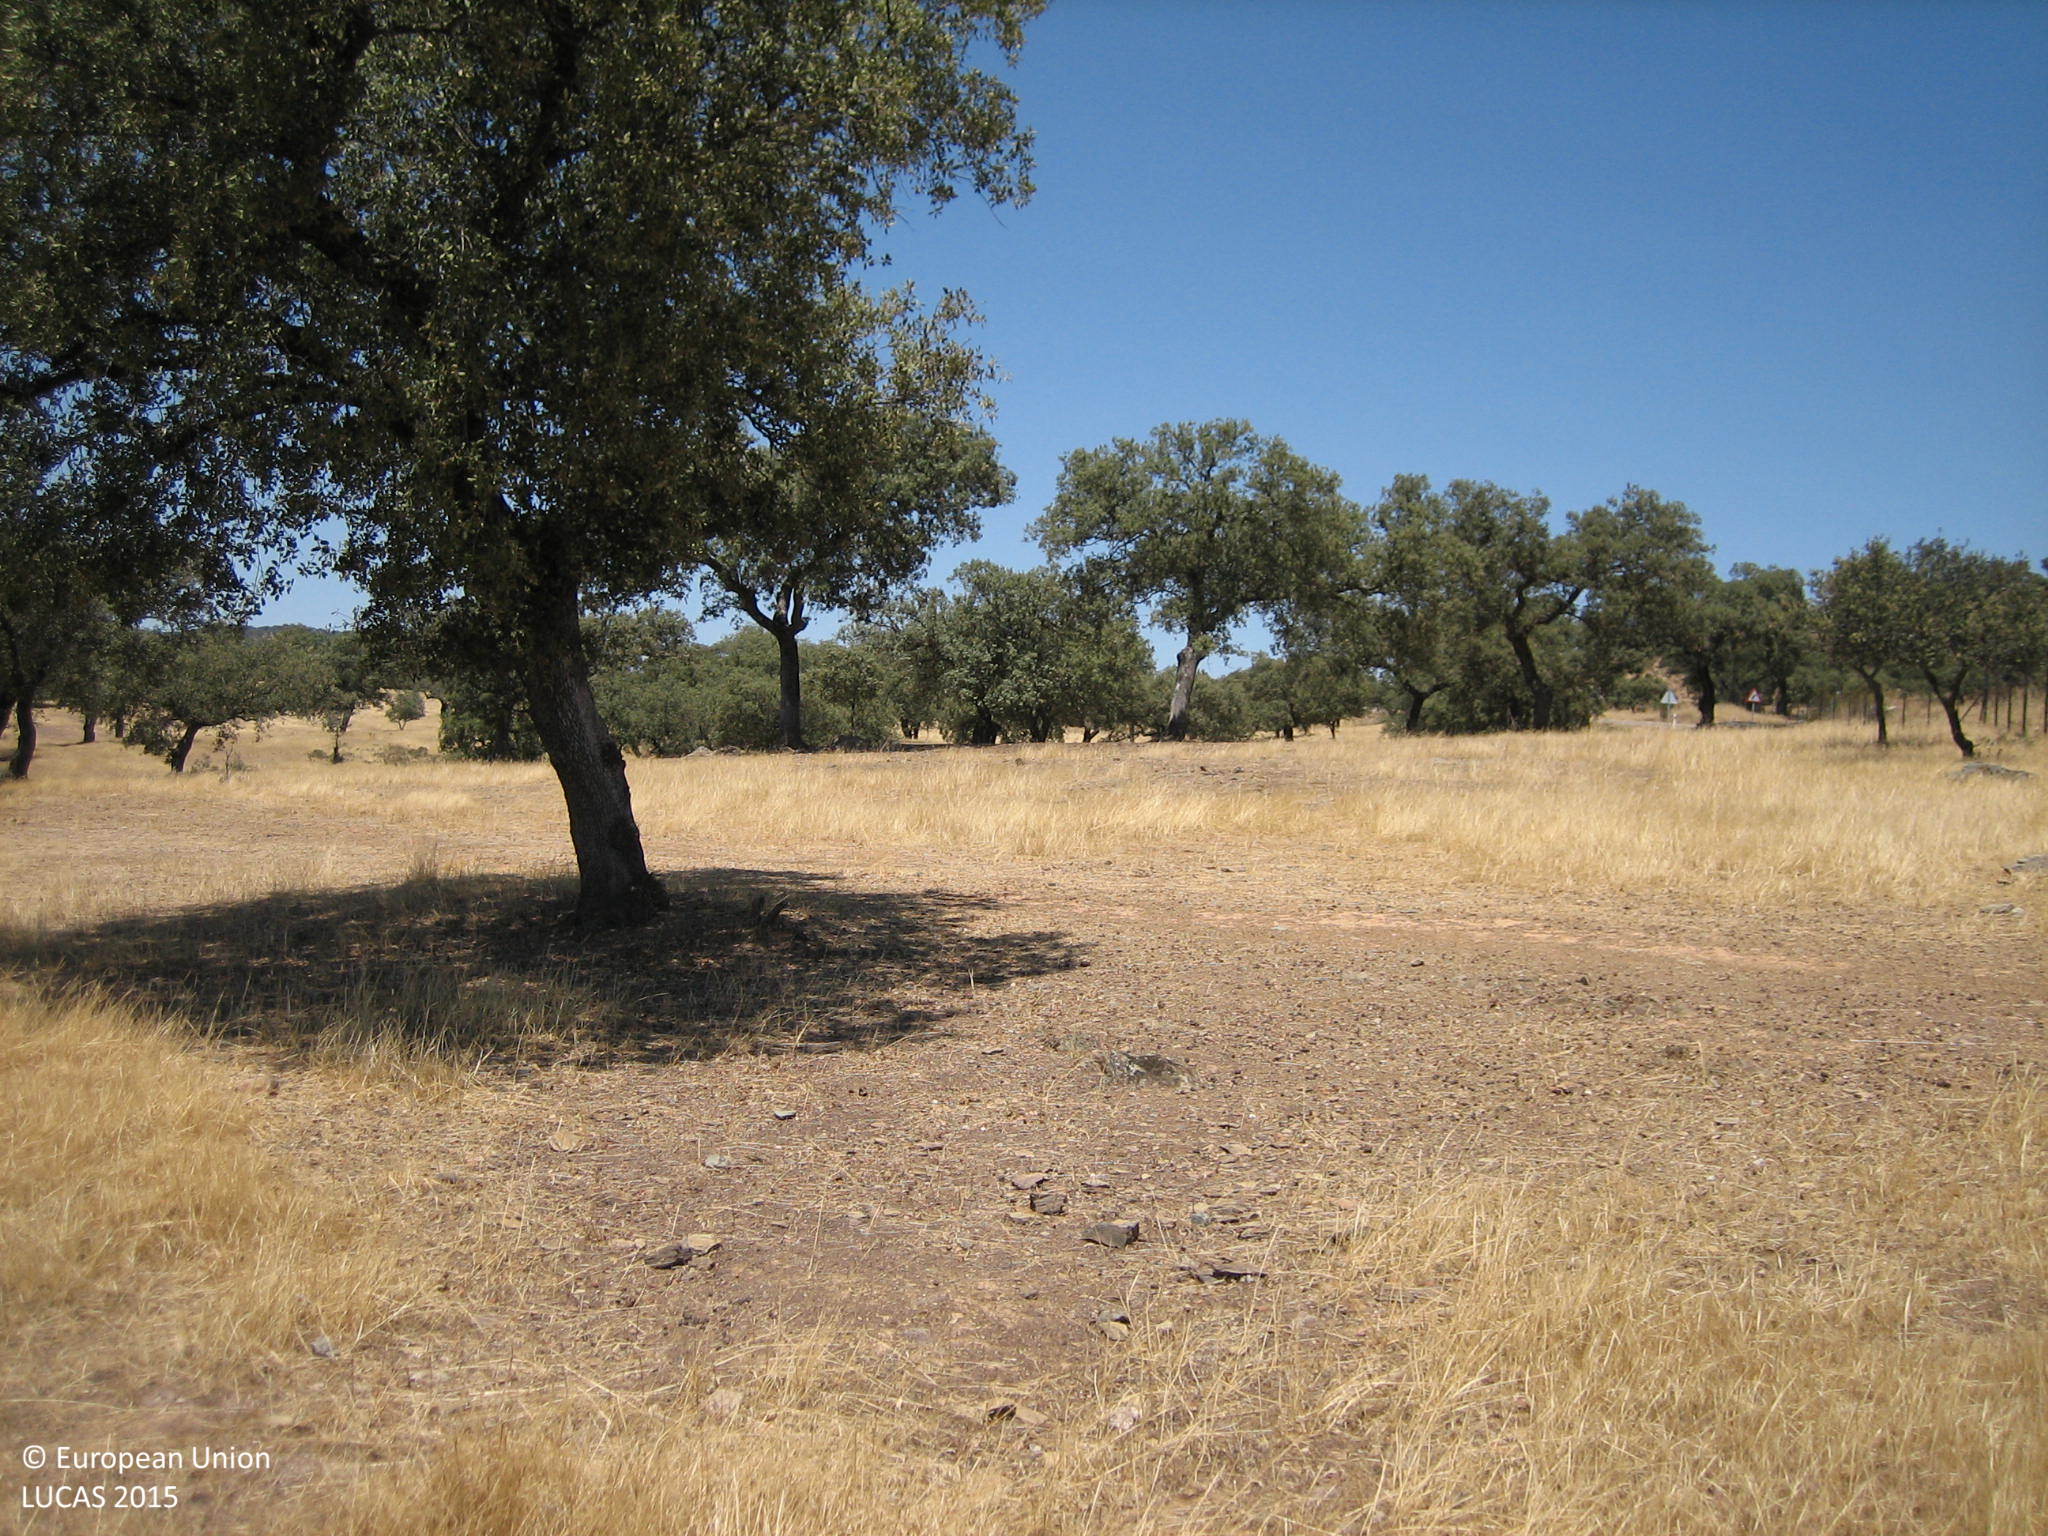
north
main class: Woodland
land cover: Broadleaved woodland
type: broadleaved evergreen forest
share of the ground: 10 - 25 %
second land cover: Grassland without tree/shrub cover
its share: > 75 %
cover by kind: herbaceous plants 90 %, broadleaved forest trees 10 %
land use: Forestry
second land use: Agriculture (excluding fallow land and kitchen gardens)
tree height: > 5 m
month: July
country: ES
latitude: 38.1764
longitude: -6.0783
